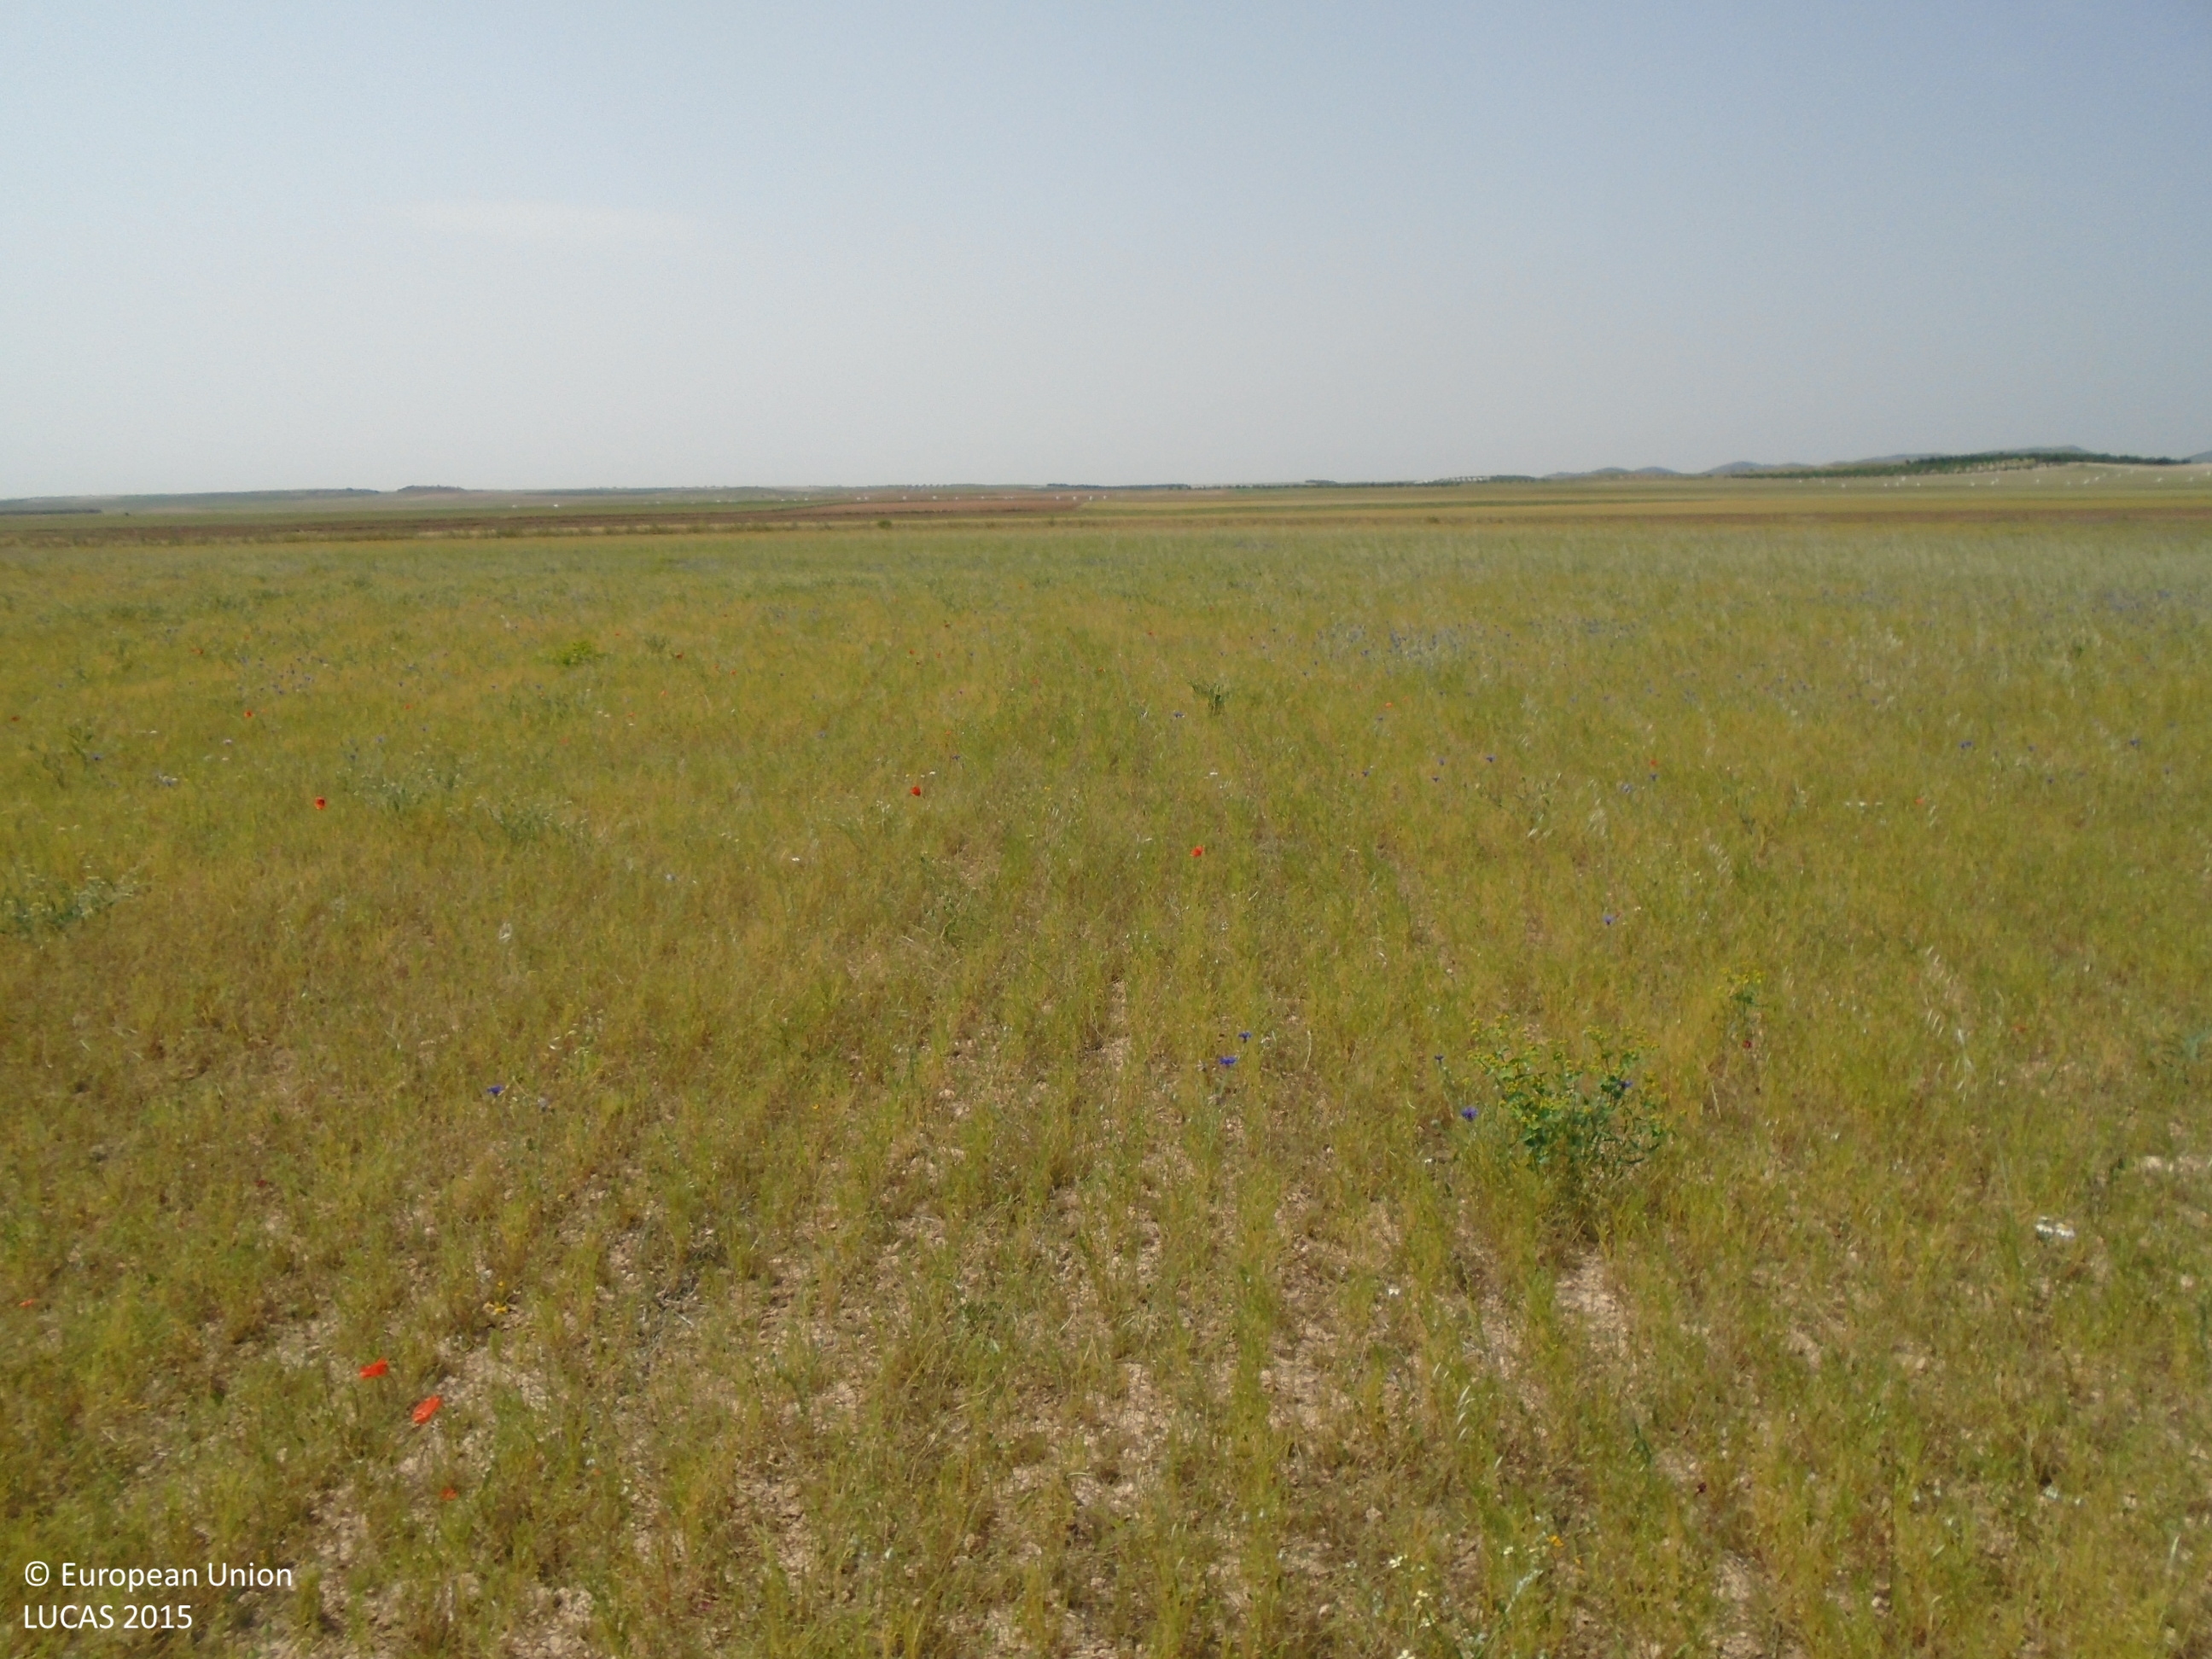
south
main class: Cropland
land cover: Dry pulses
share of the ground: > 75 %
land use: Agriculture (excluding fallow land and kitchen gardens)
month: May
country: ES
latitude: 39.7339
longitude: -3.6207
